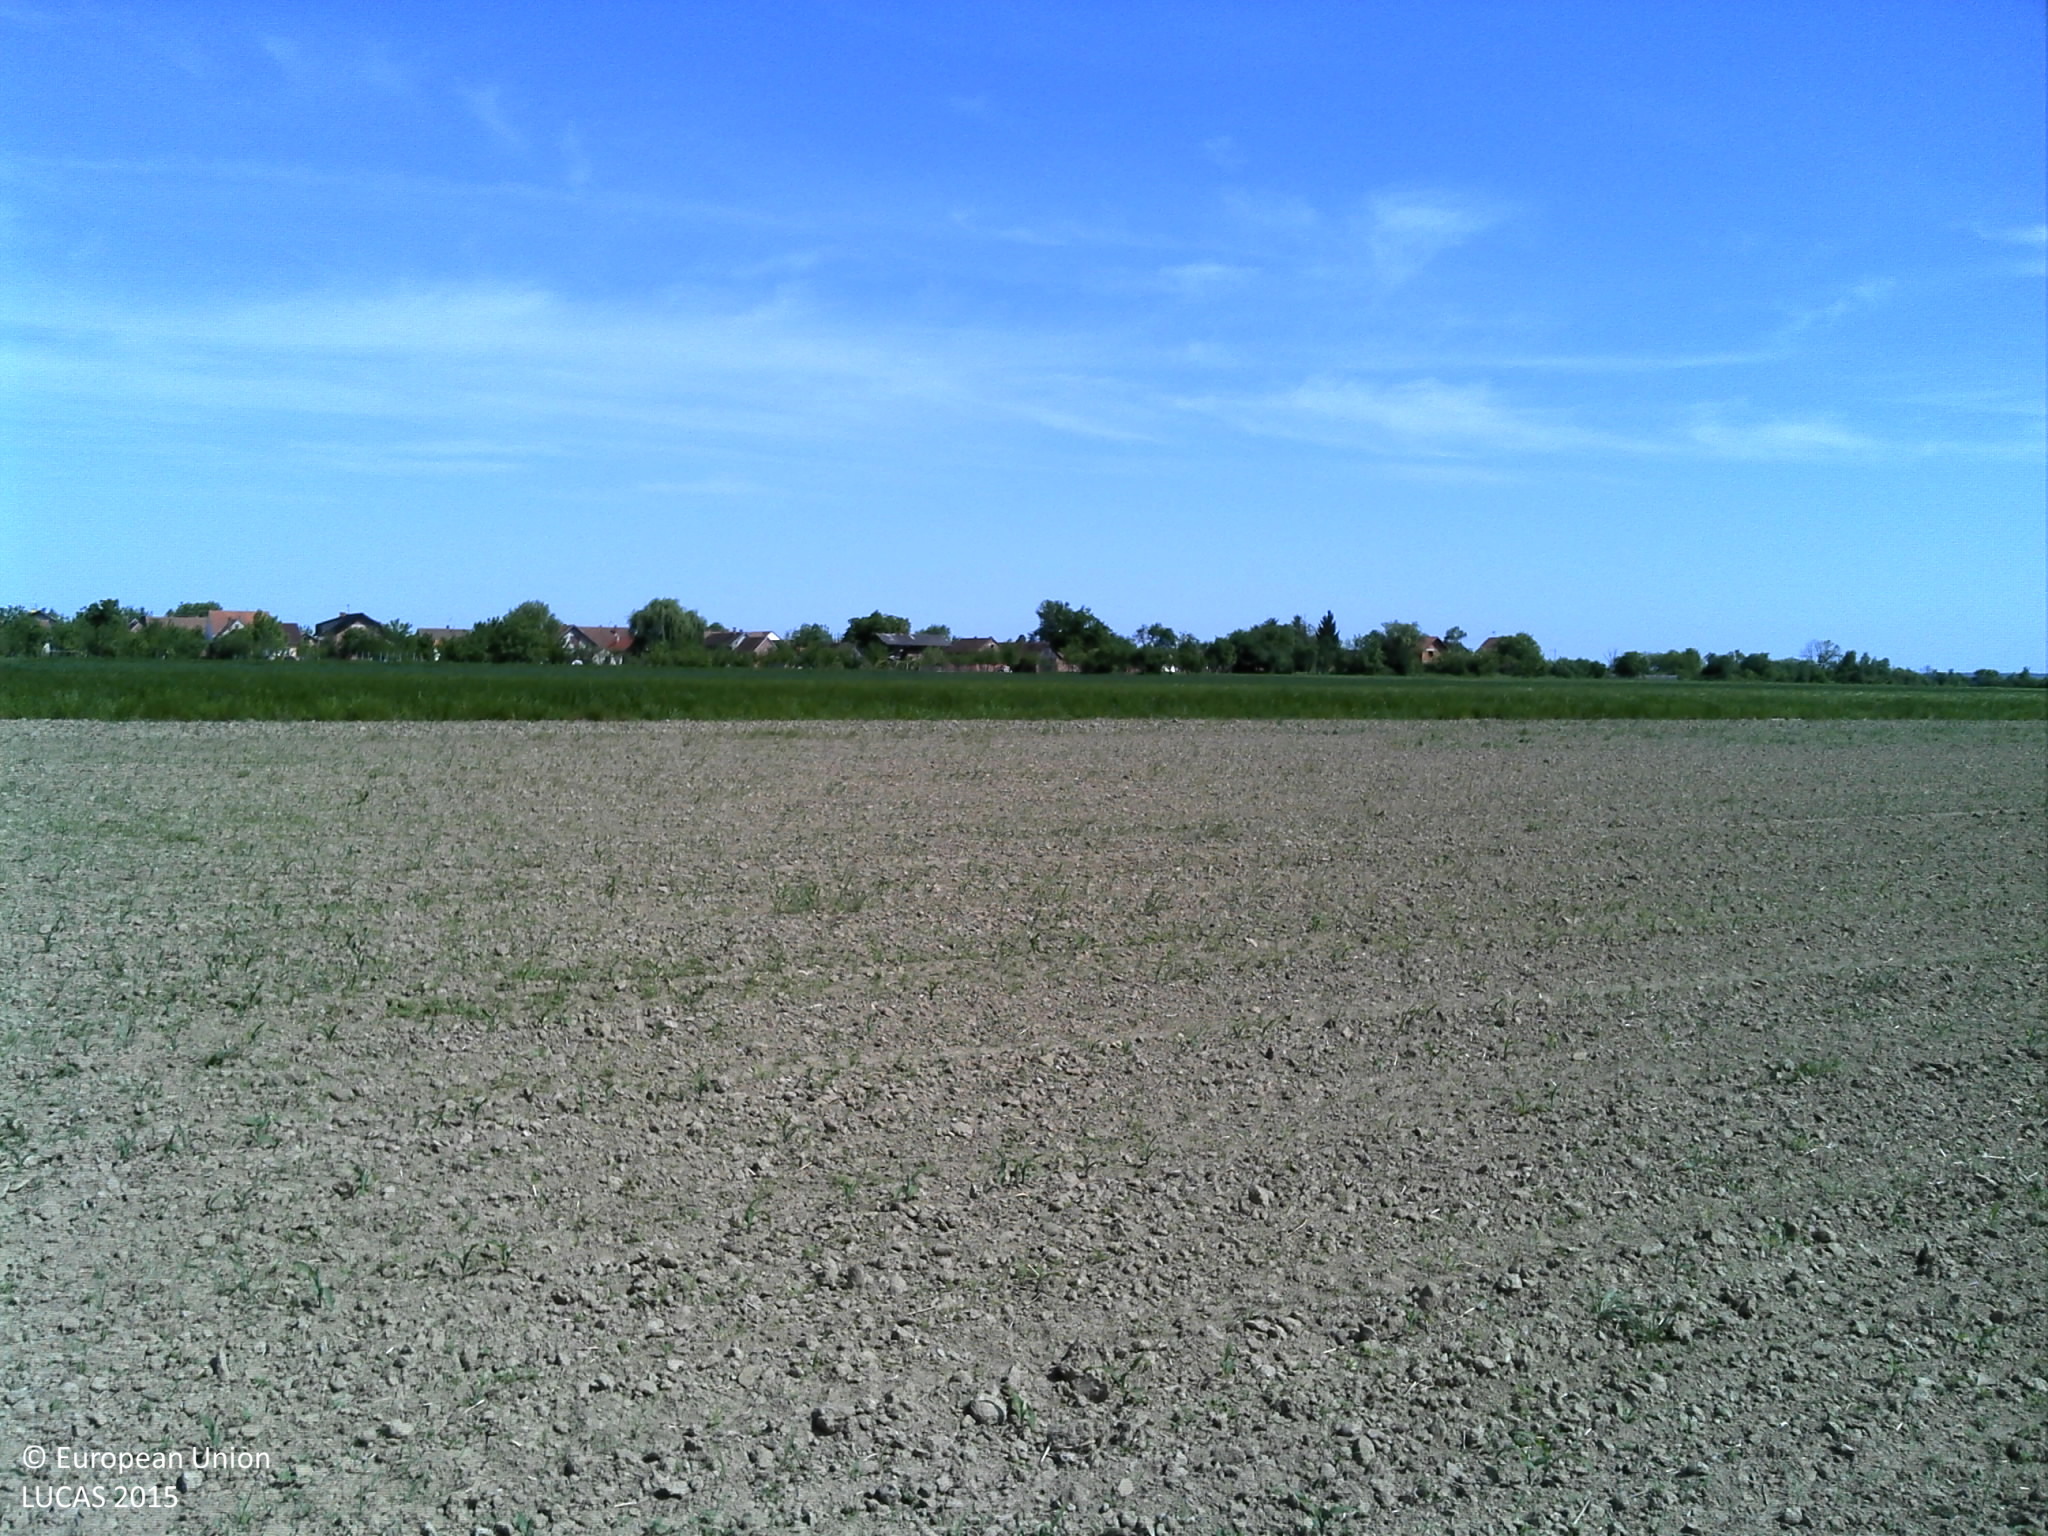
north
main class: Cropland
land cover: Maize
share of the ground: < 10 %
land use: Agriculture (excluding fallow land and kitchen gardens)
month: May
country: HR
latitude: 45.4546
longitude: 18.2270
